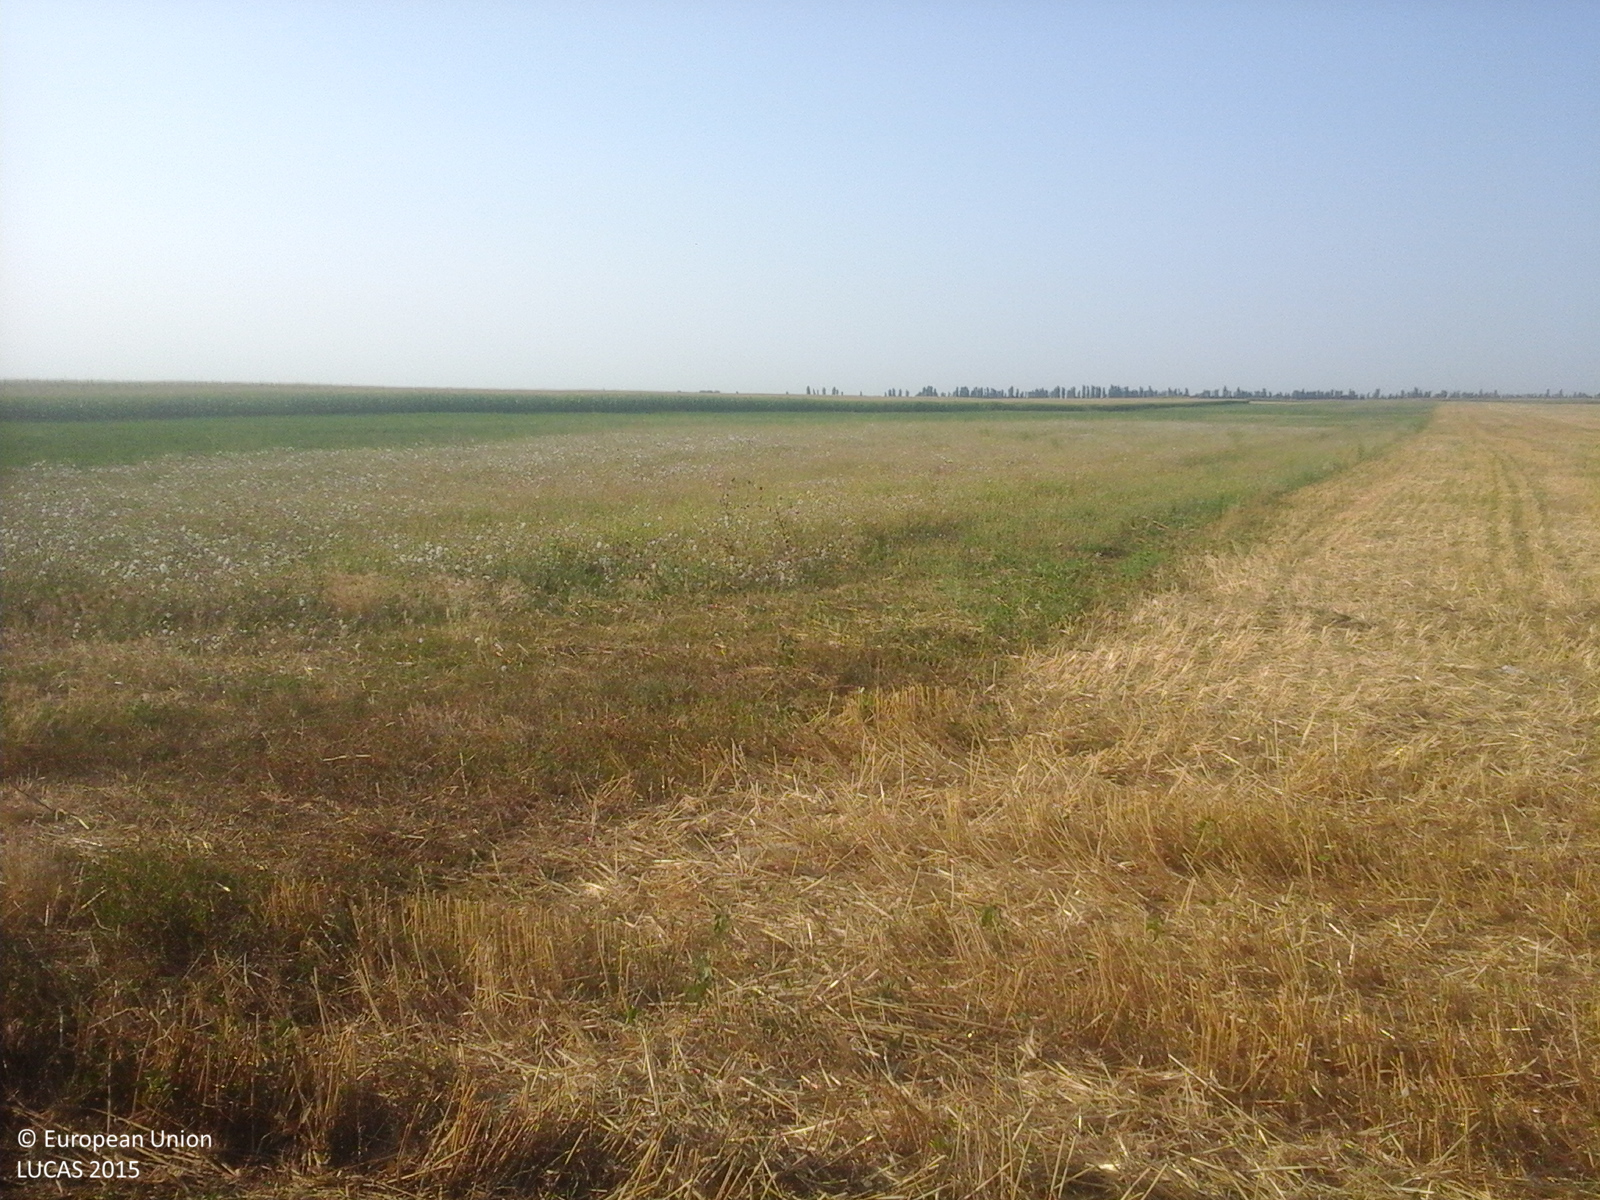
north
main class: Cropland
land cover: Maize
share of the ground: > 75 %
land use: Agriculture (excluding fallow land and kitchen gardens)
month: July
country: RO
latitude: 44.8626
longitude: 27.5760
